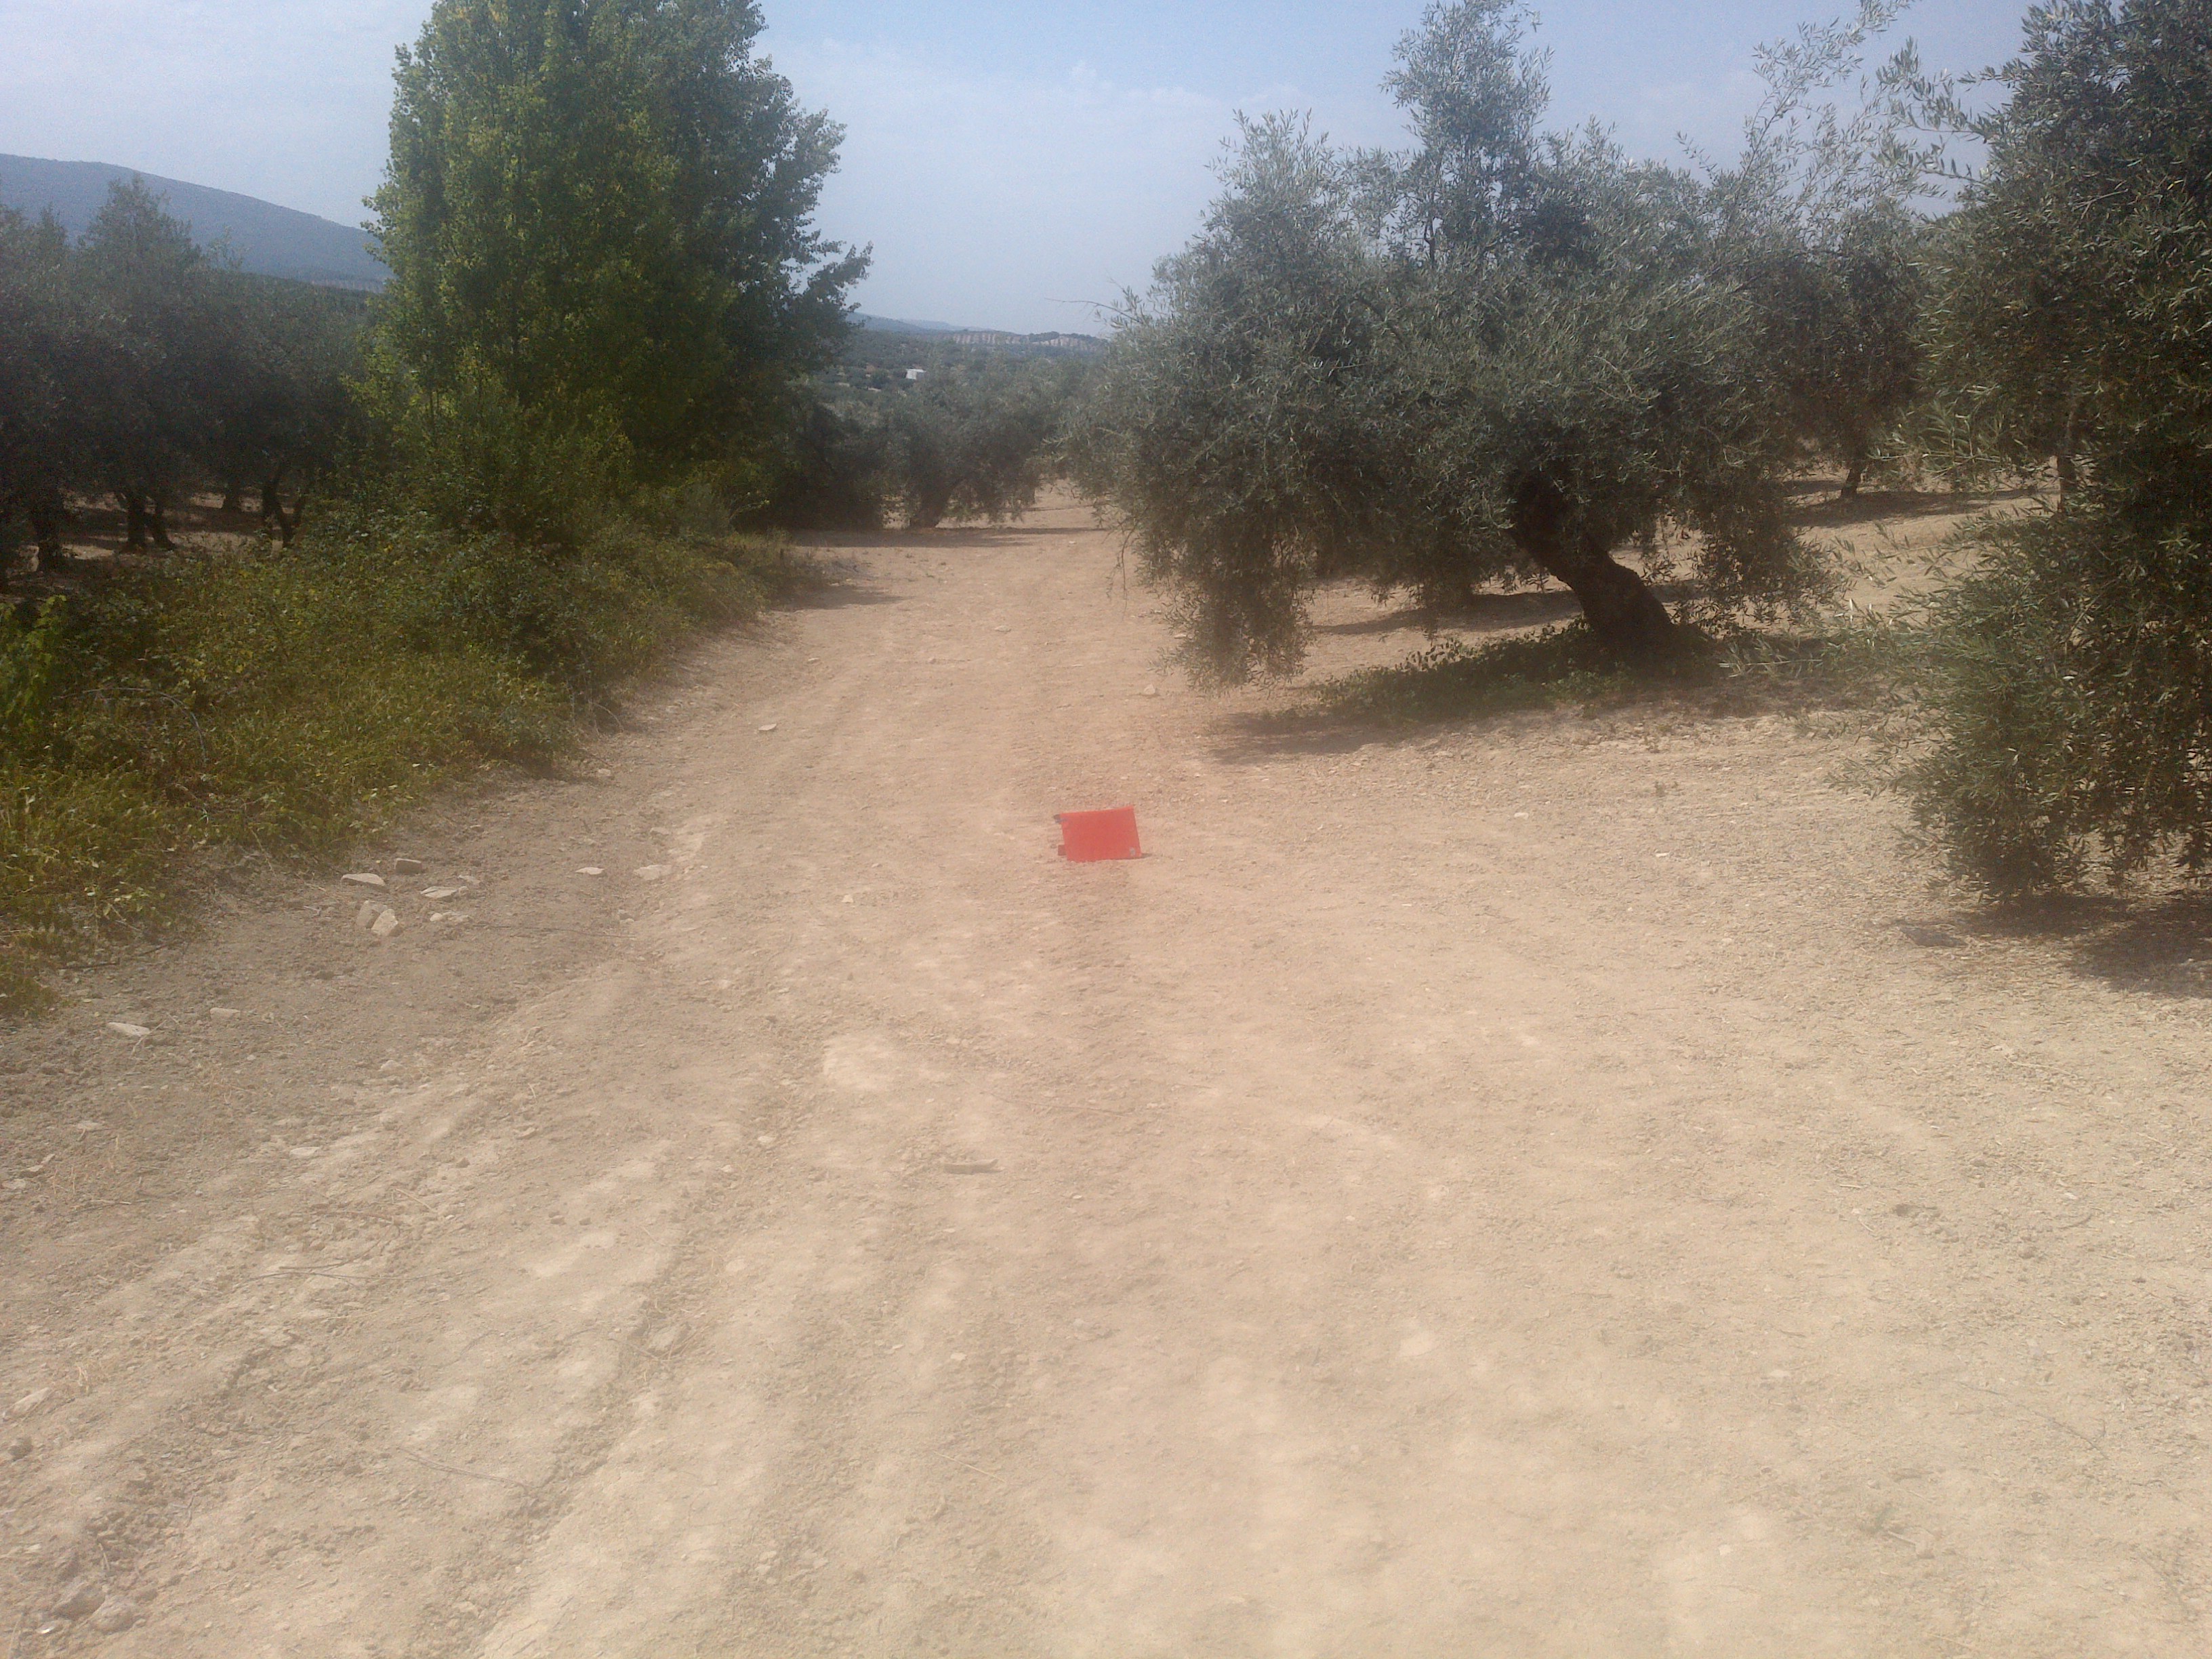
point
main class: Cropland
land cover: Olive groves
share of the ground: 50 - 75 %
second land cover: Other bare soil
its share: > 75 %
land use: Agriculture (excluding fallow land and kitchen gardens)
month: July
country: ES
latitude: 37.5409
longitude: -4.4343
